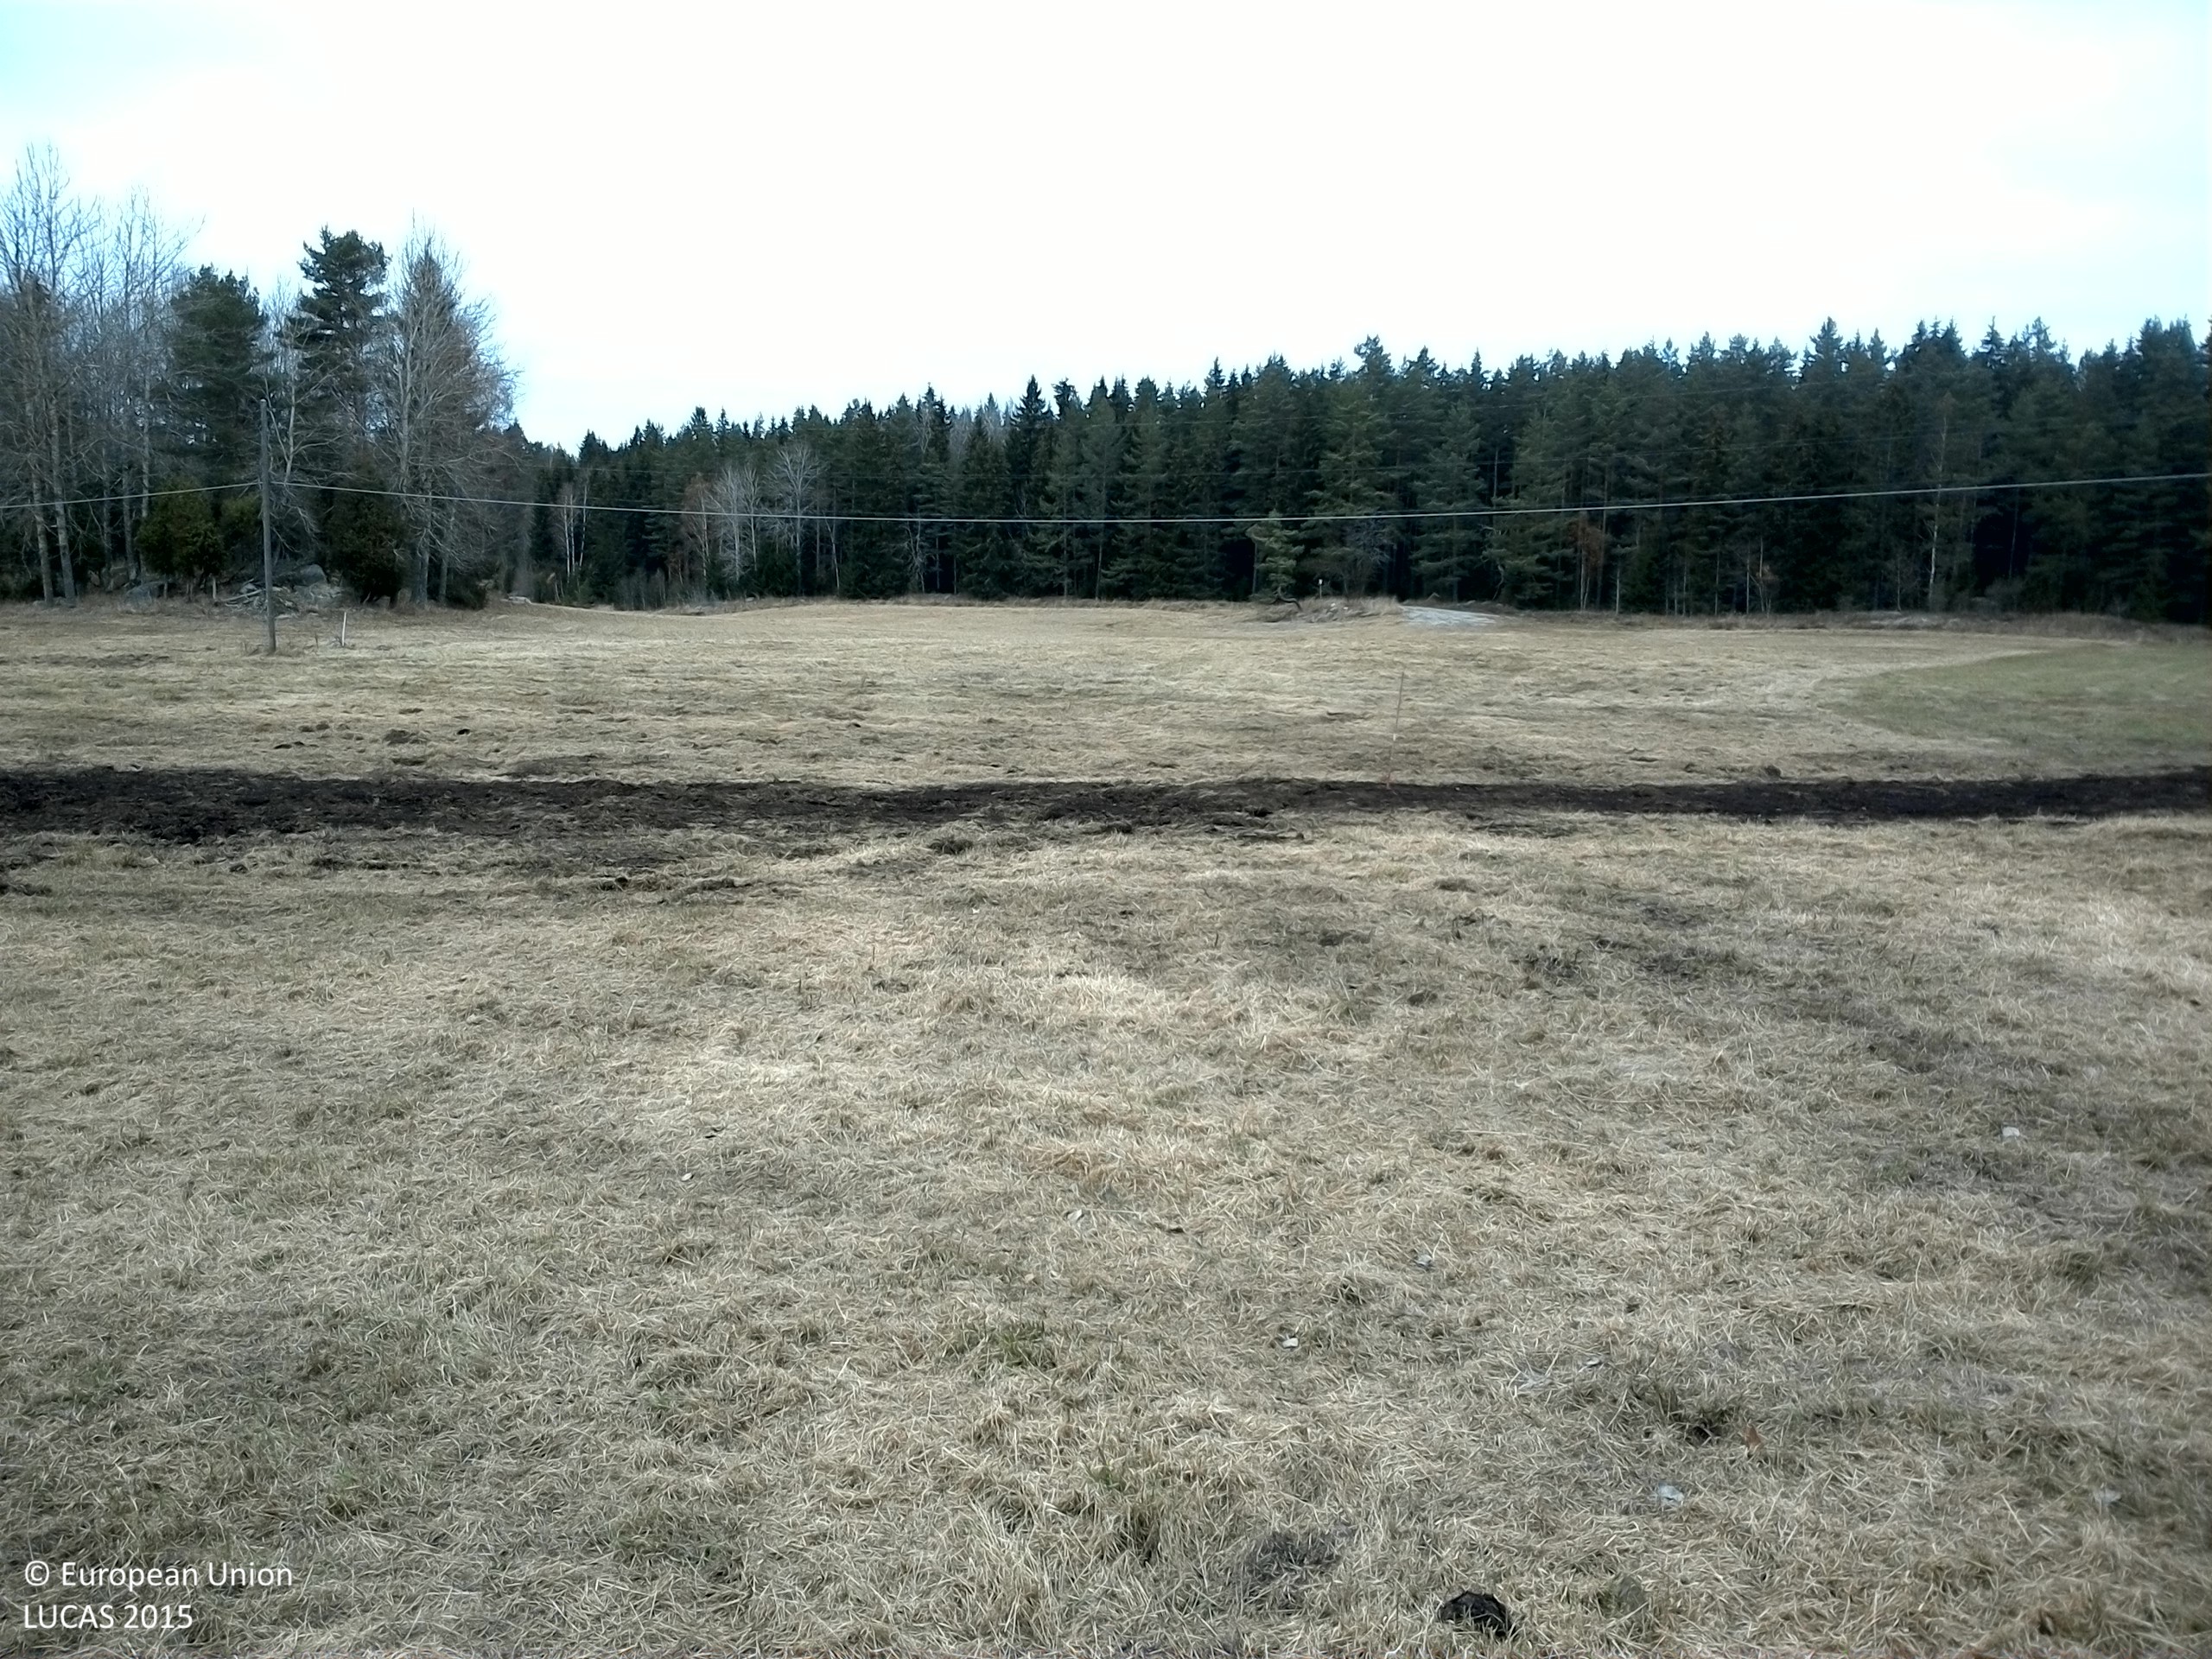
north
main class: Grassland
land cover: Grassland without tree/shrub cover
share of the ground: > 75 %
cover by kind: herbaceous plants 100 %
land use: Agriculture (excluding fallow land and kitchen gardens)
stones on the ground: < 10 %
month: October
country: SE
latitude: 59.1372
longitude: 17.0386
